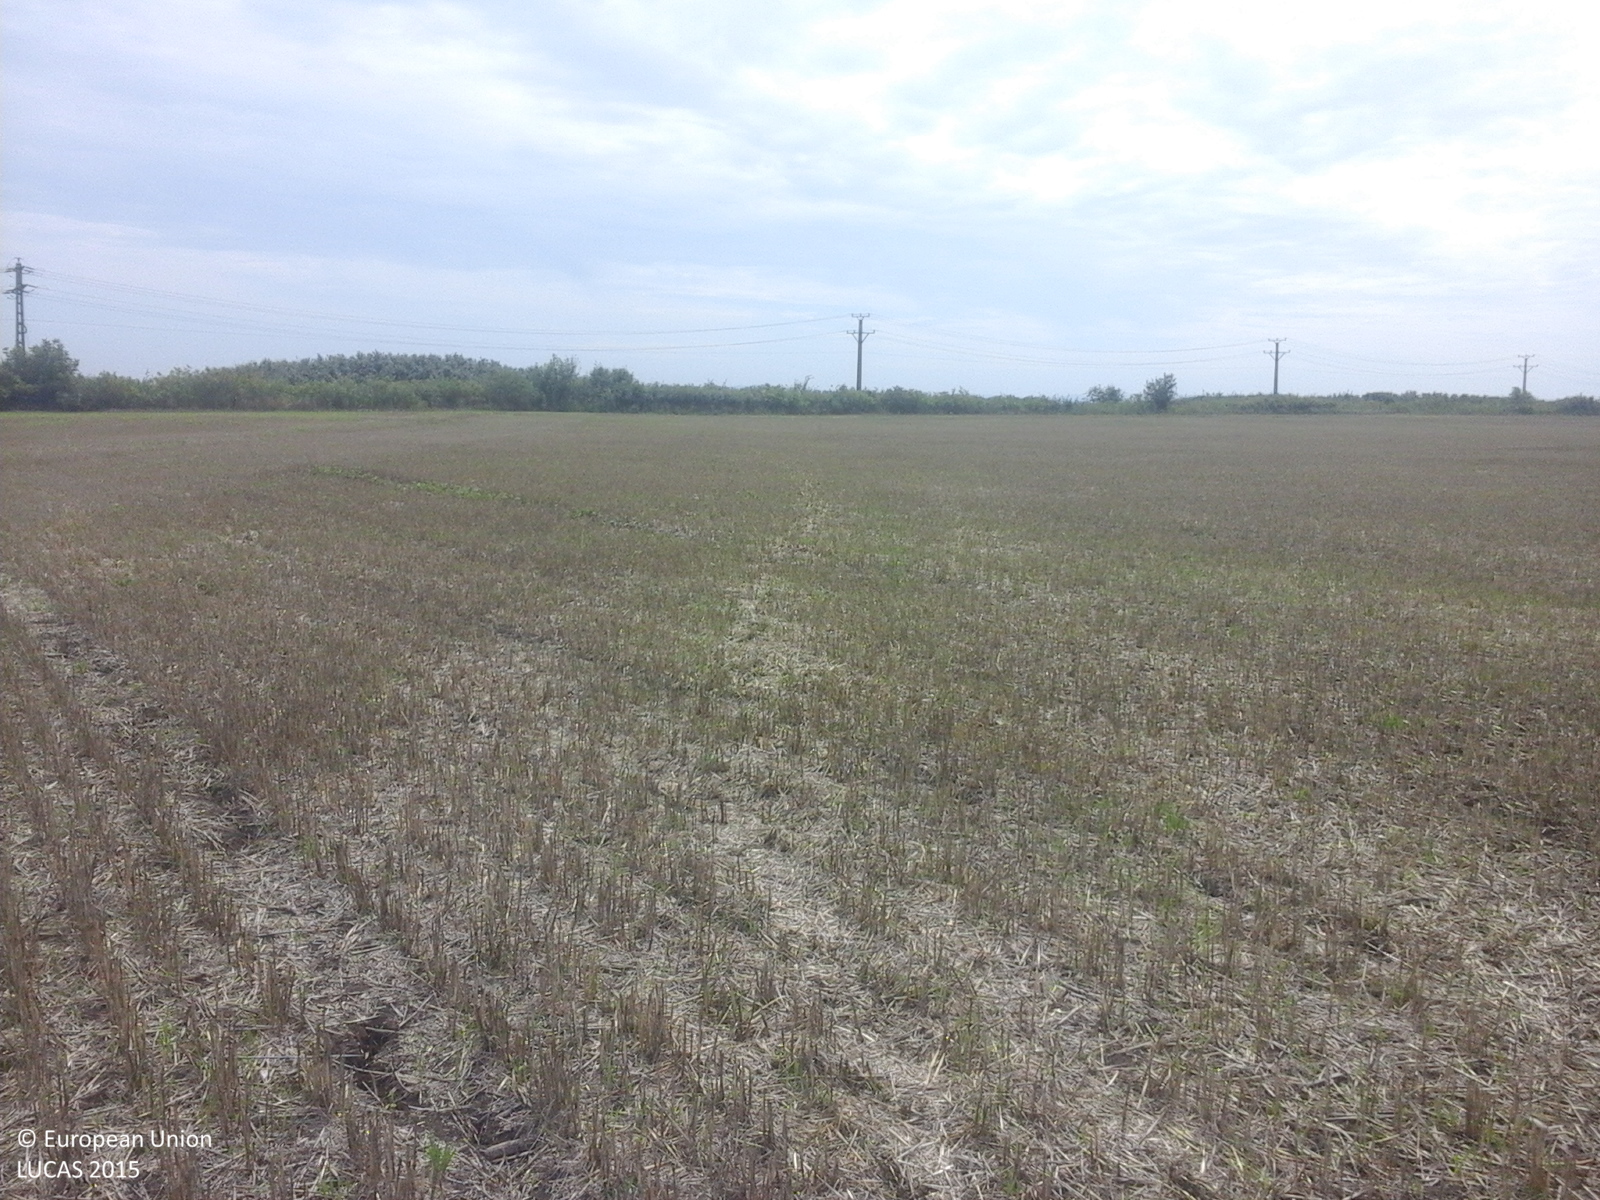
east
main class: Cropland
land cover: Common wheat
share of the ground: 50 - 75 %
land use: Agriculture (excluding fallow land and kitchen gardens)
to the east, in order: Common wheat; Tracks; Abandoned hedges; Ditches and canals; Abandoned hedges; Grass margins; Tracks; Grass margins; Maize; Electric lines; Maize
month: August
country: RO
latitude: 46.4102
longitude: 21.4191
